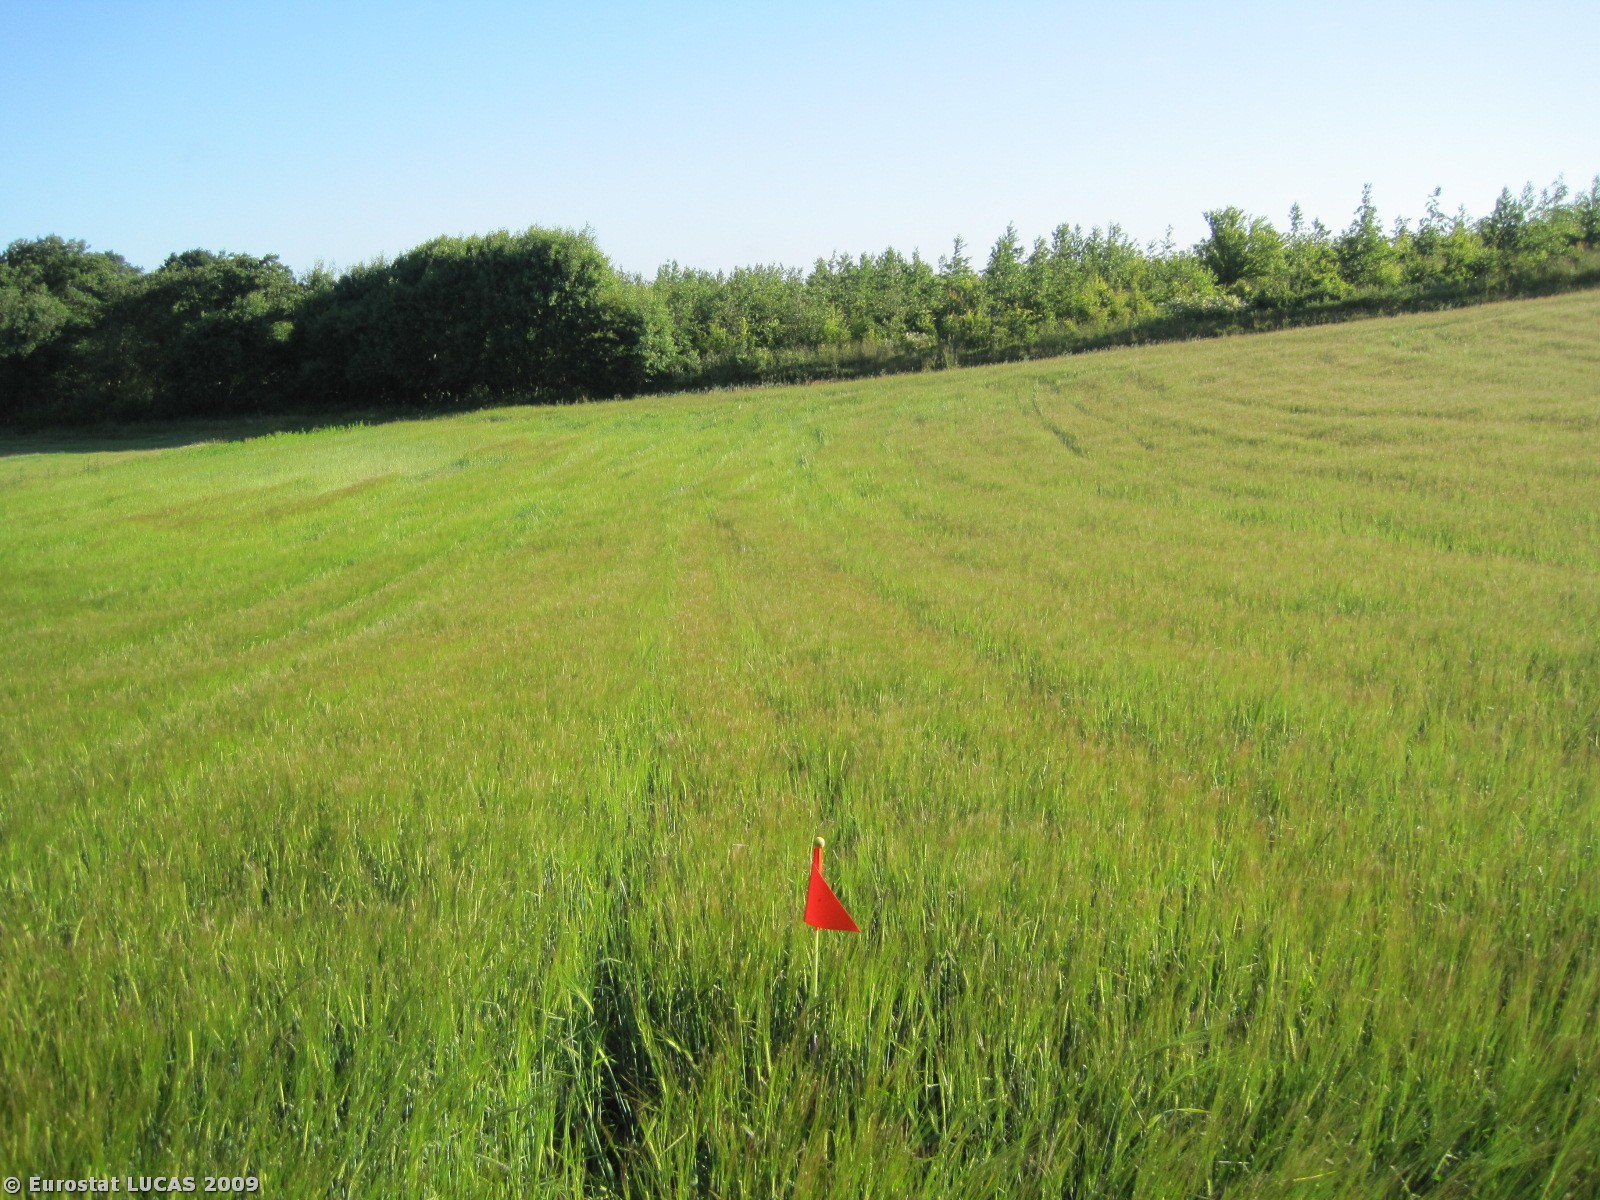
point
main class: Cropland
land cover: Barley
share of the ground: > 75 %
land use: Agriculture (excluding fallow land and kitchen gardens)
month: June
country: DK
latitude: 56.6167
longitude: 9.2026
